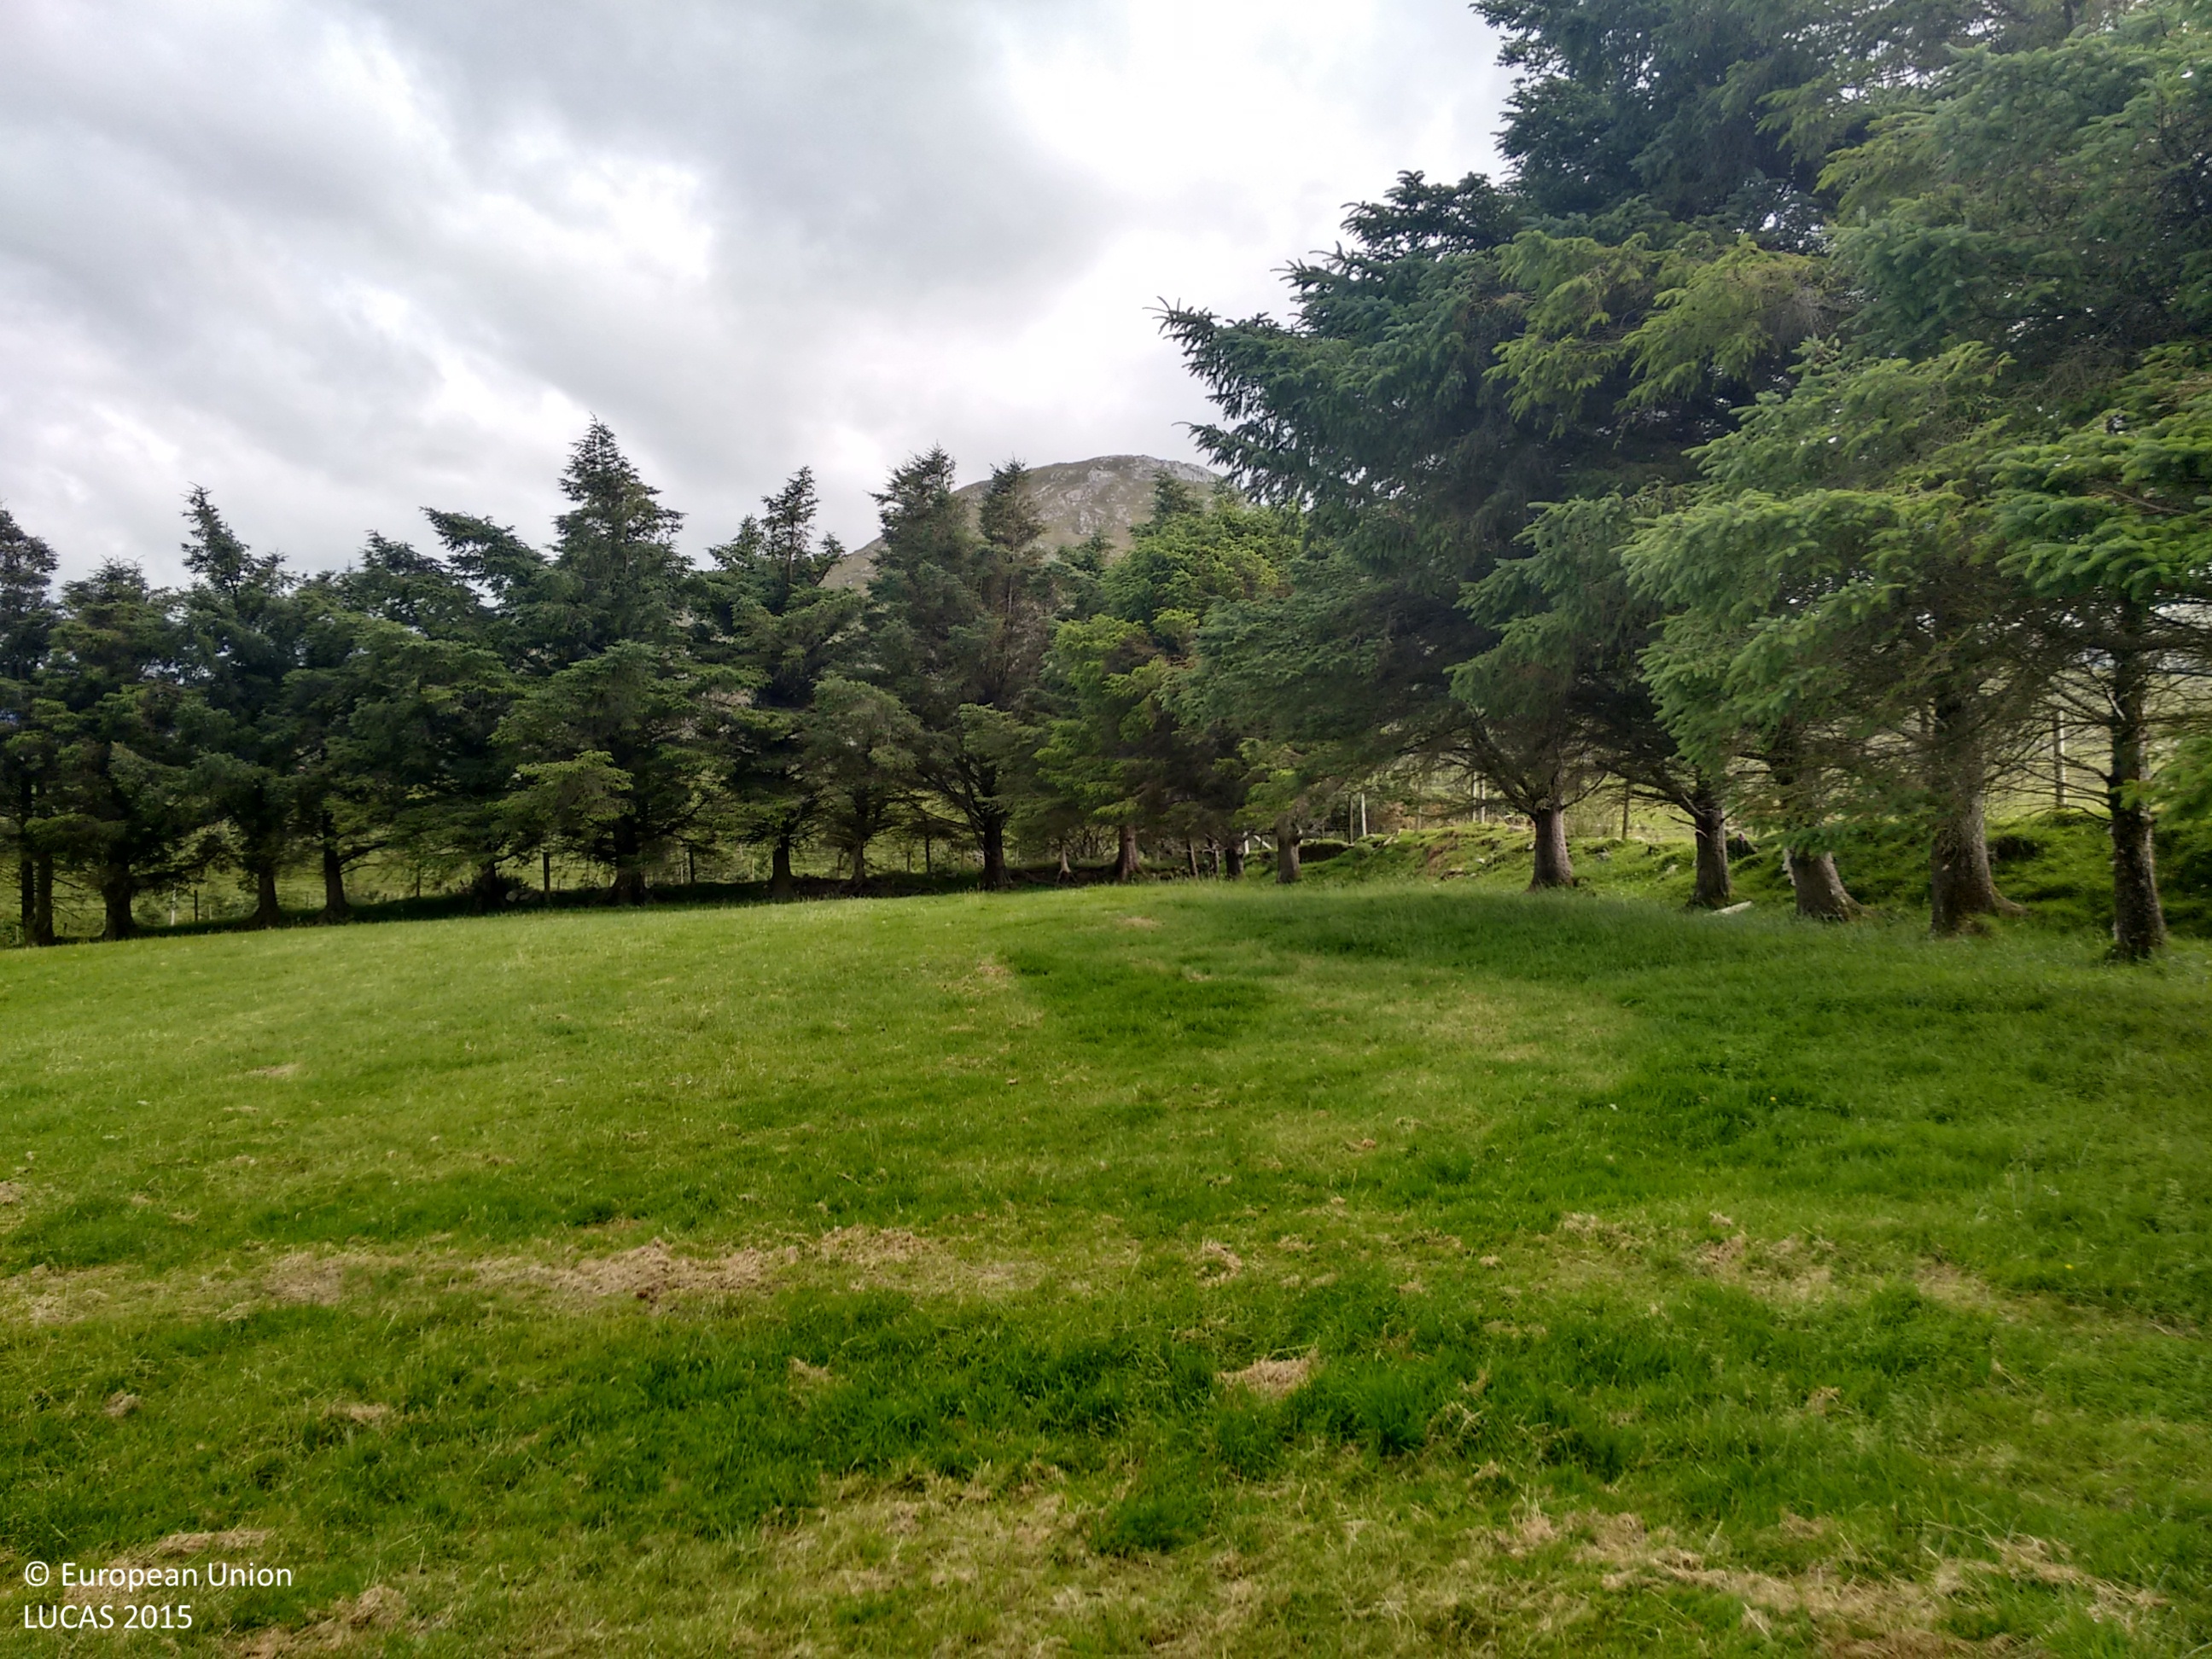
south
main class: Grassland
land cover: Grassland without tree/shrub cover
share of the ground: > 75 %
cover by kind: herbaceous plants 100 %
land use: Agriculture (excluding fallow land and kitchen gardens)
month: July
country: IE
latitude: 53.6982
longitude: -9.6405
